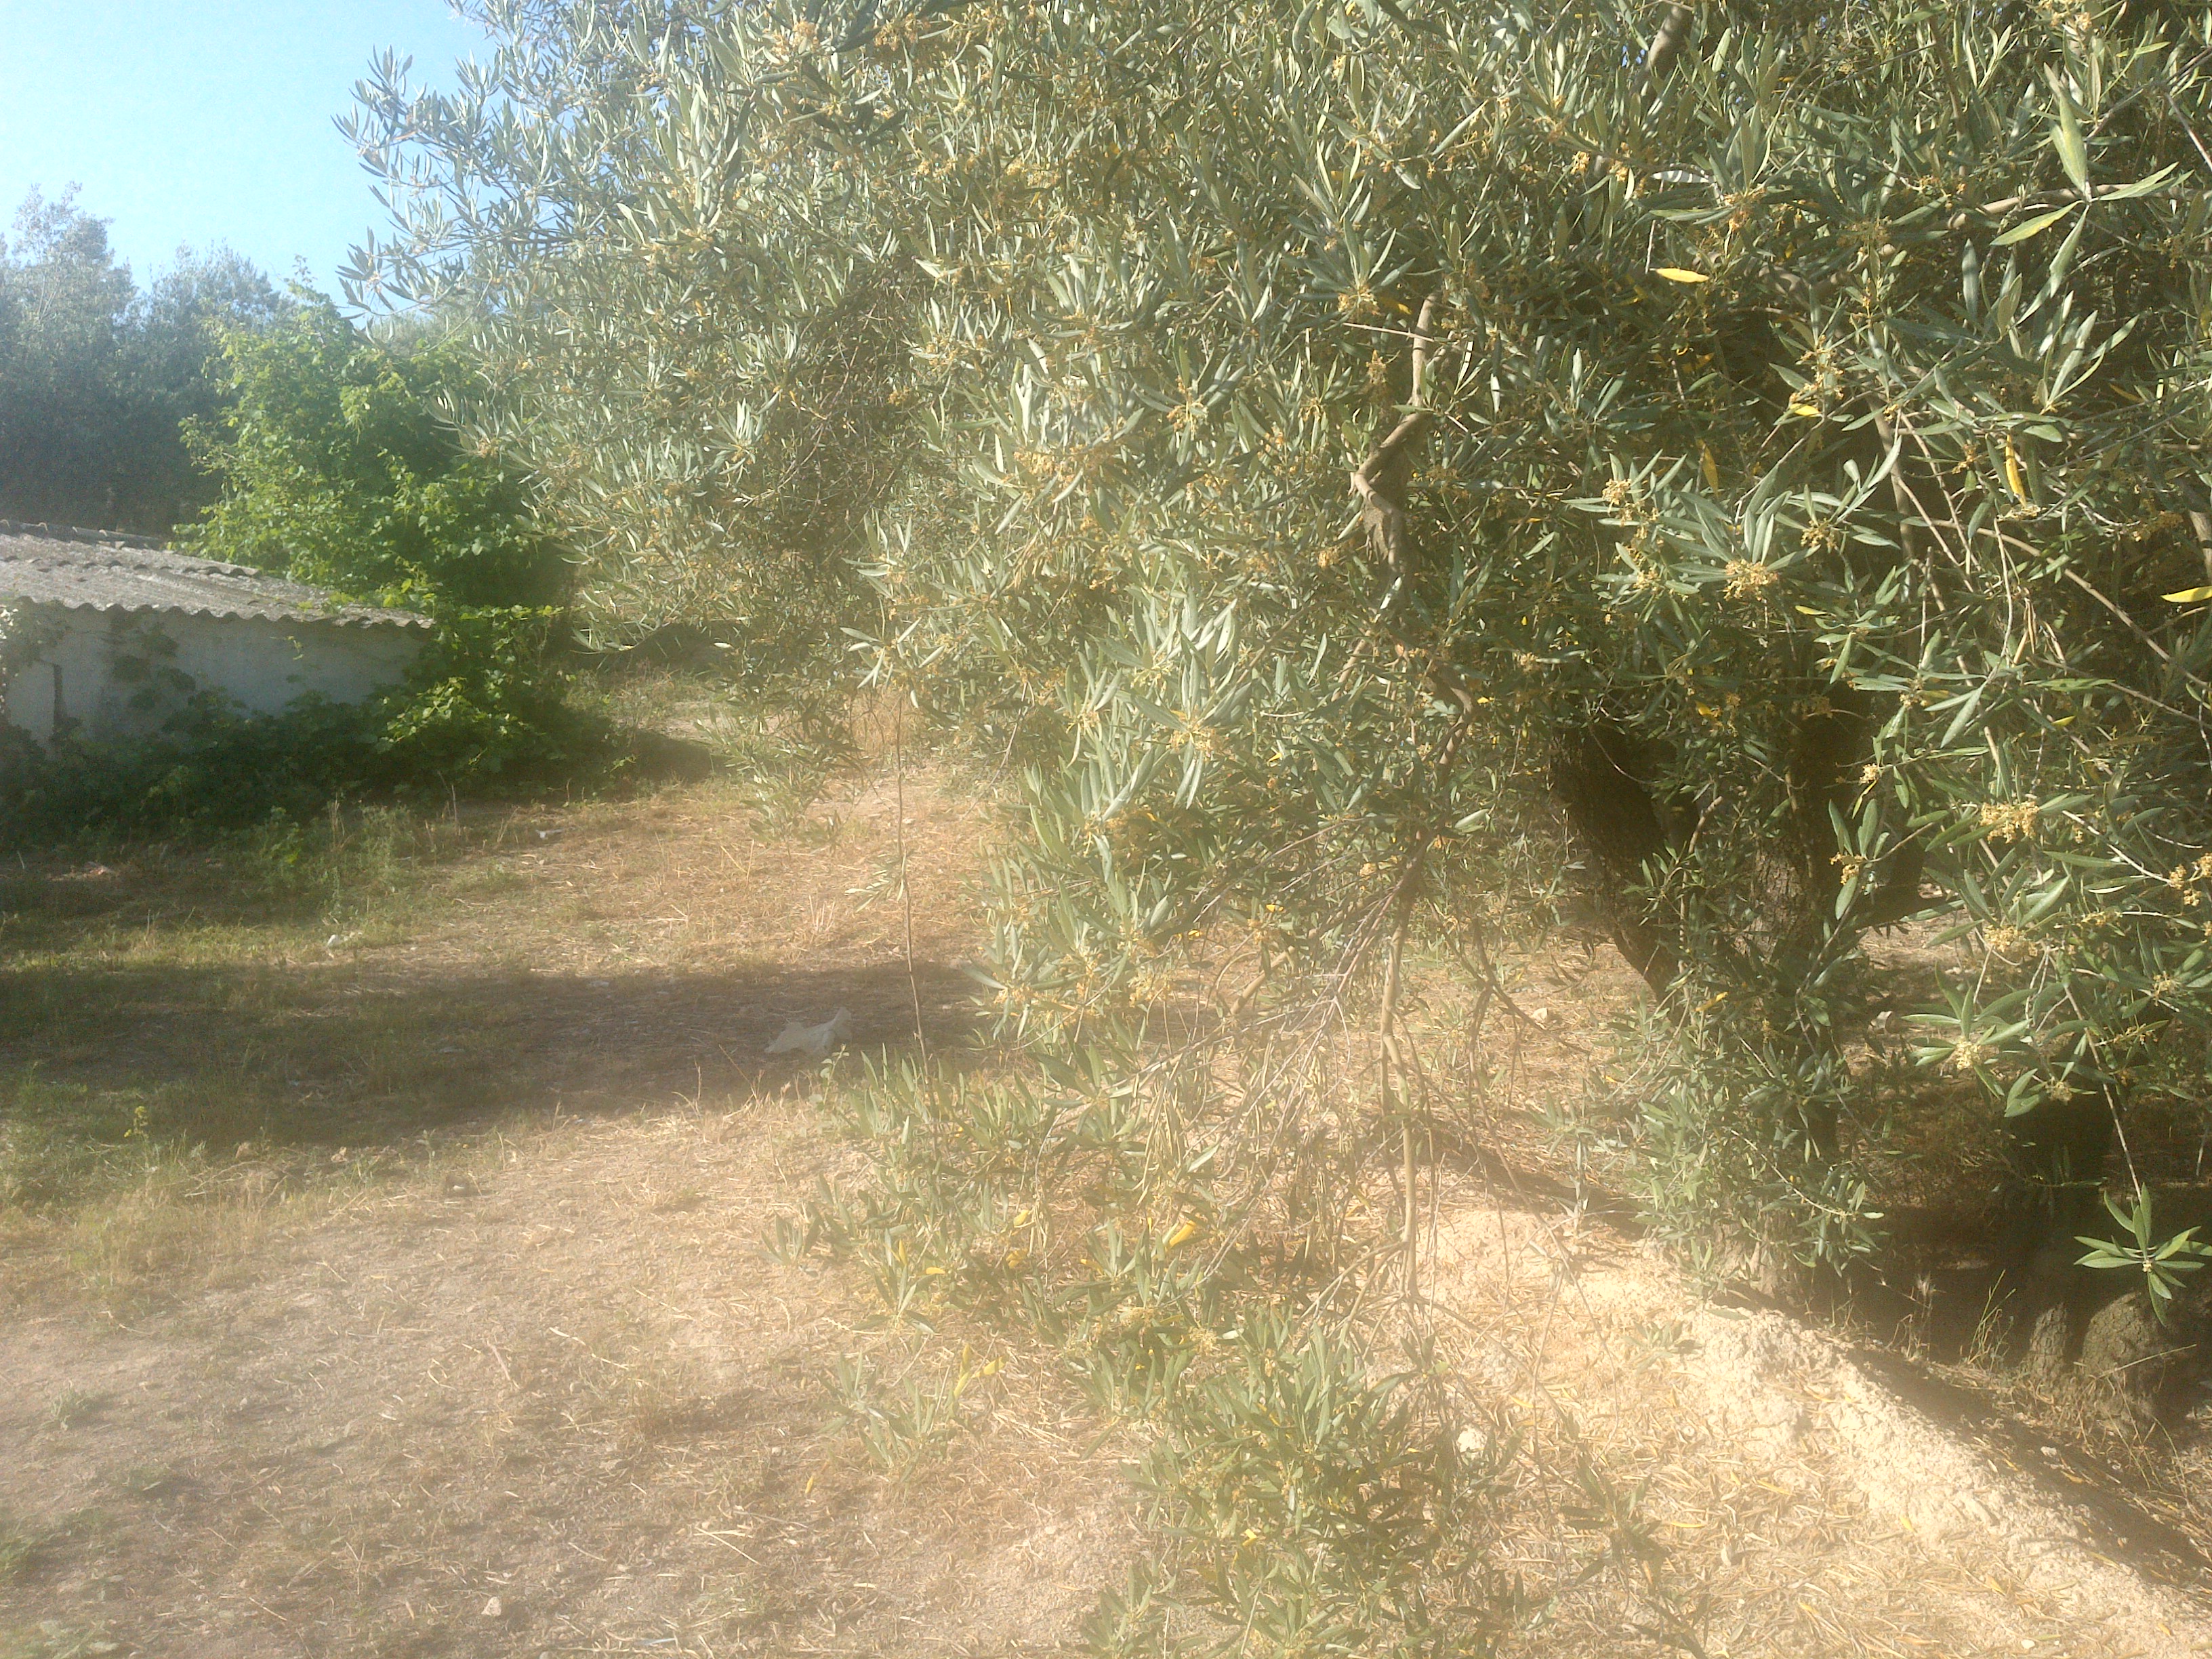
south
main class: Cropland
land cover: Olive groves
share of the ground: 25 - 50 %
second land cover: Spontaneously vegetated surfaces
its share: 50 - 75 %
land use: Agriculture (excluding fallow land and kitchen gardens)
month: May
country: ES
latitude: 37.4634
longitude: -4.0976
